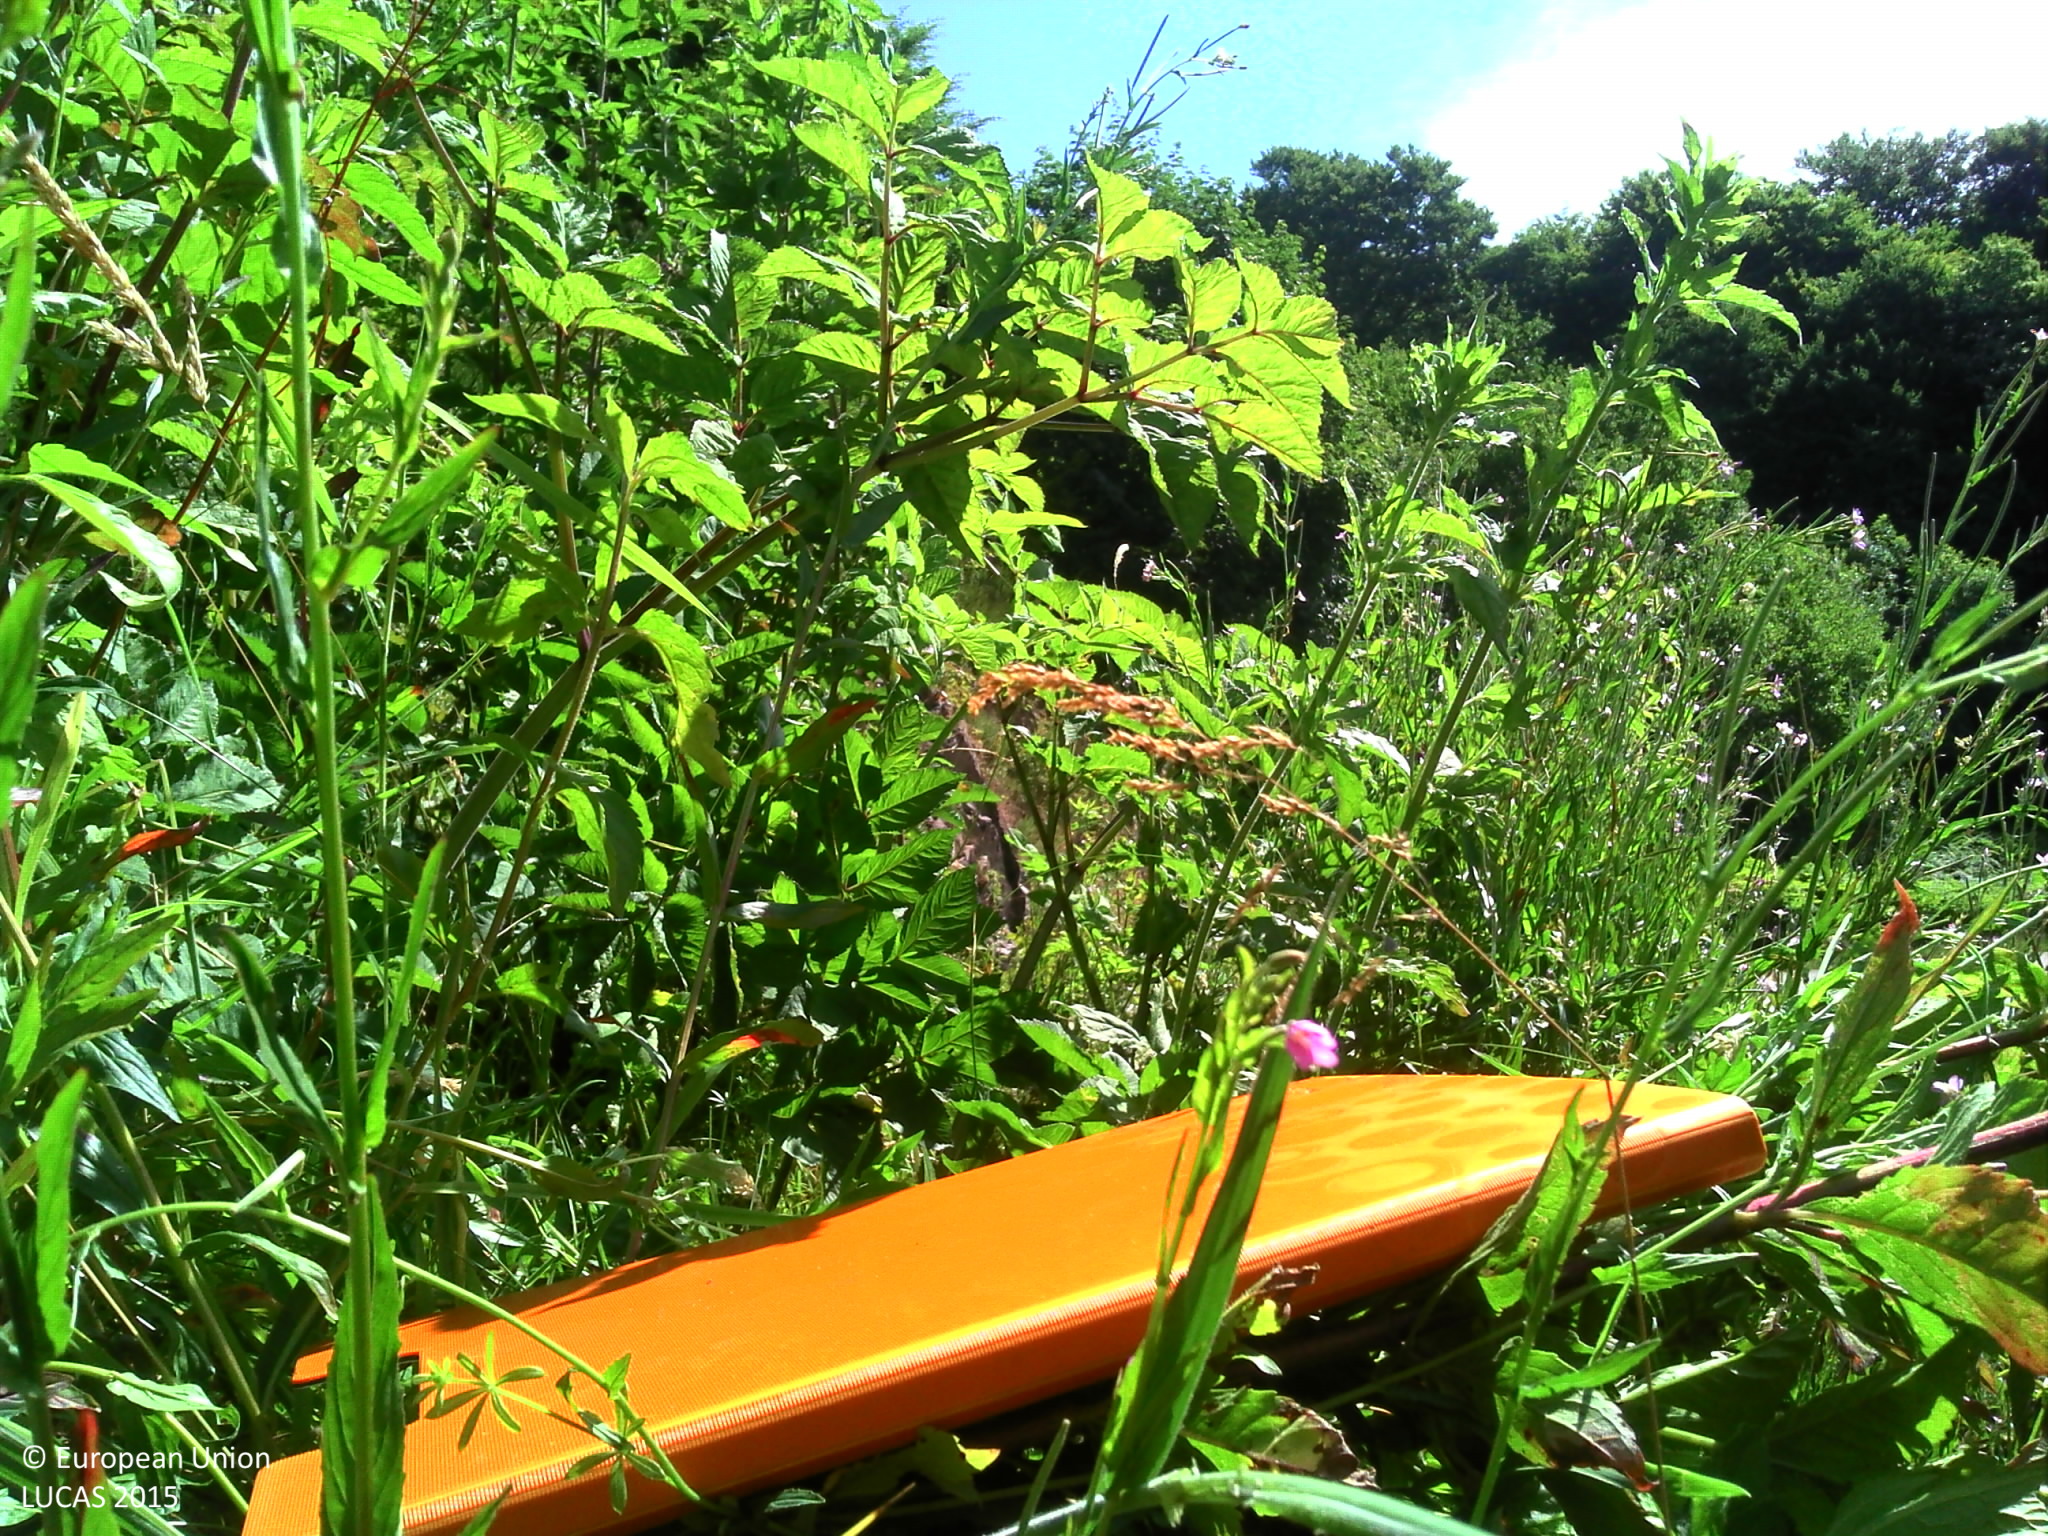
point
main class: Grassland
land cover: Spontaneously vegetated surfaces
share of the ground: > 75 %
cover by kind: herbaceous plants 95 %, shrubs 5 %
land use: Semi-natural and natural areas not in use
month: June
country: FR
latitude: 46.9423
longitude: 4.0218
